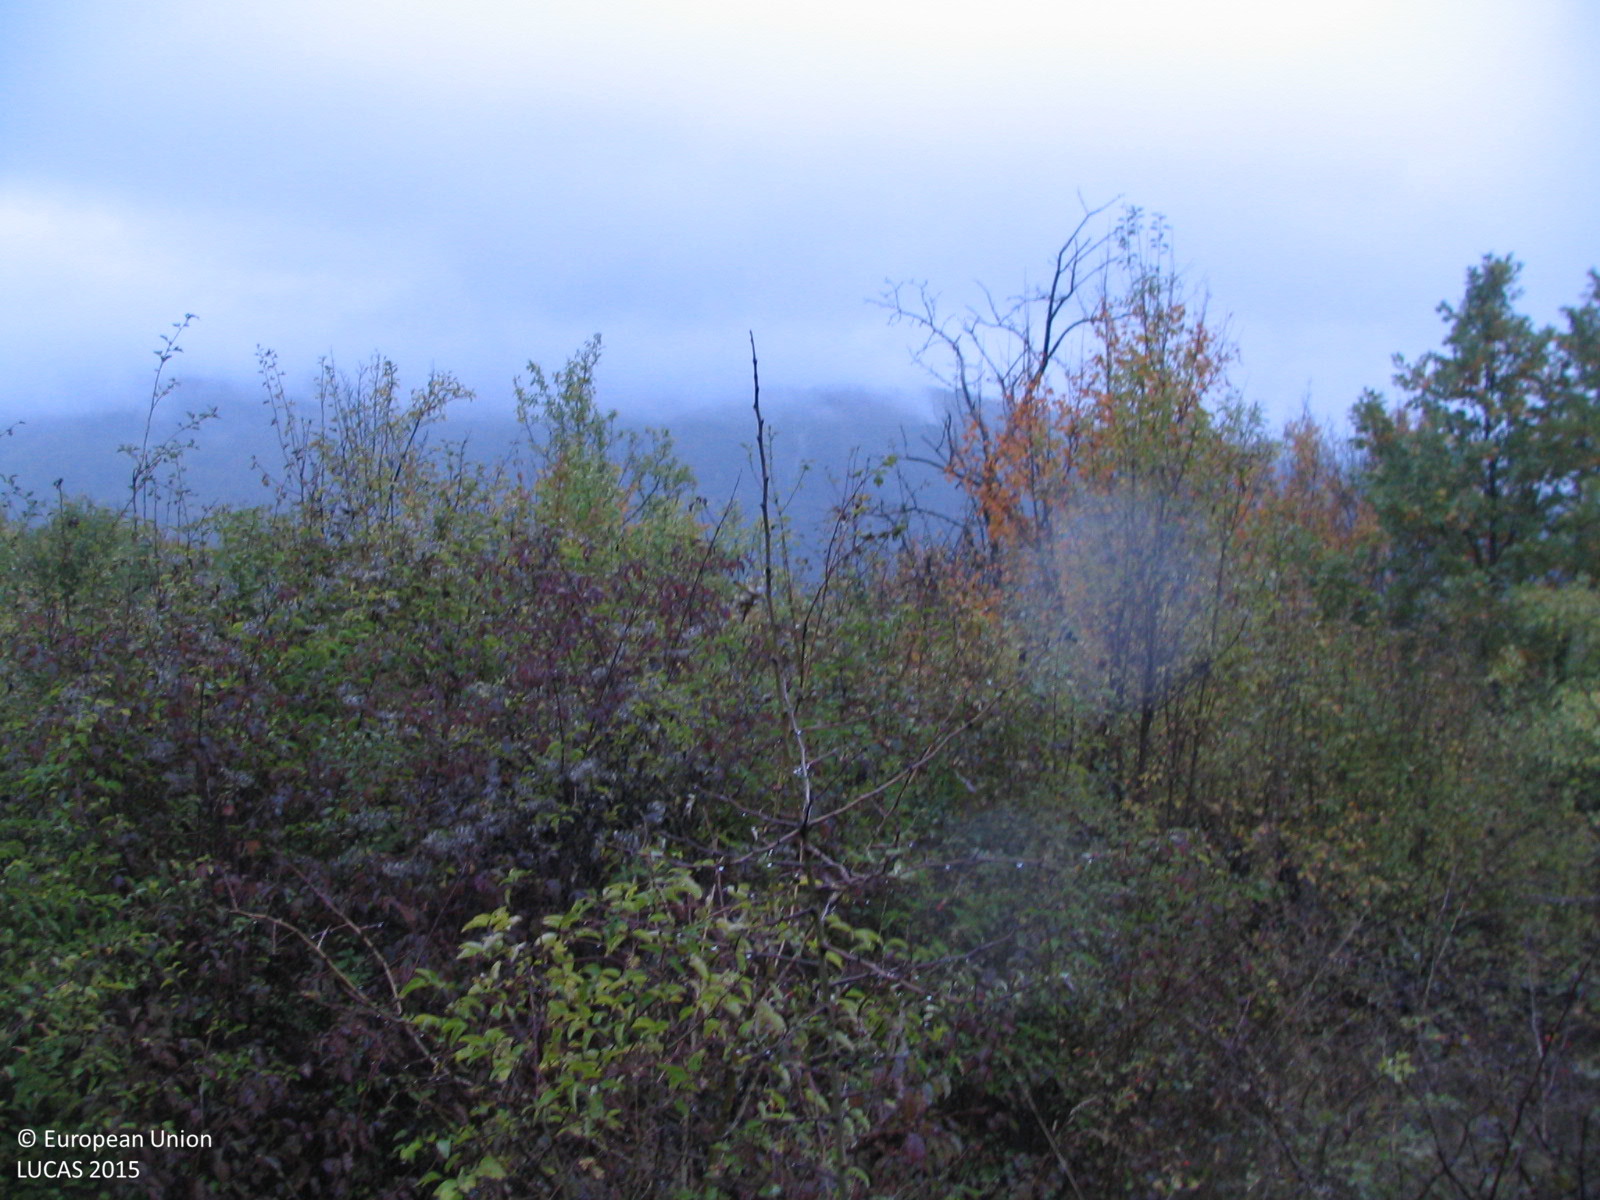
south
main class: Woodland
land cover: Broadleaved woodland
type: mesophytic deciduous forest
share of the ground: 25 - 50 %
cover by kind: shrubs 60 %, broadleaved forest trees 25 %, herbaceous plants 15 %
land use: Semi-natural and natural areas not in use
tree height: > 5 m
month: October
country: BG
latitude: 43.0046
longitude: 23.9213
